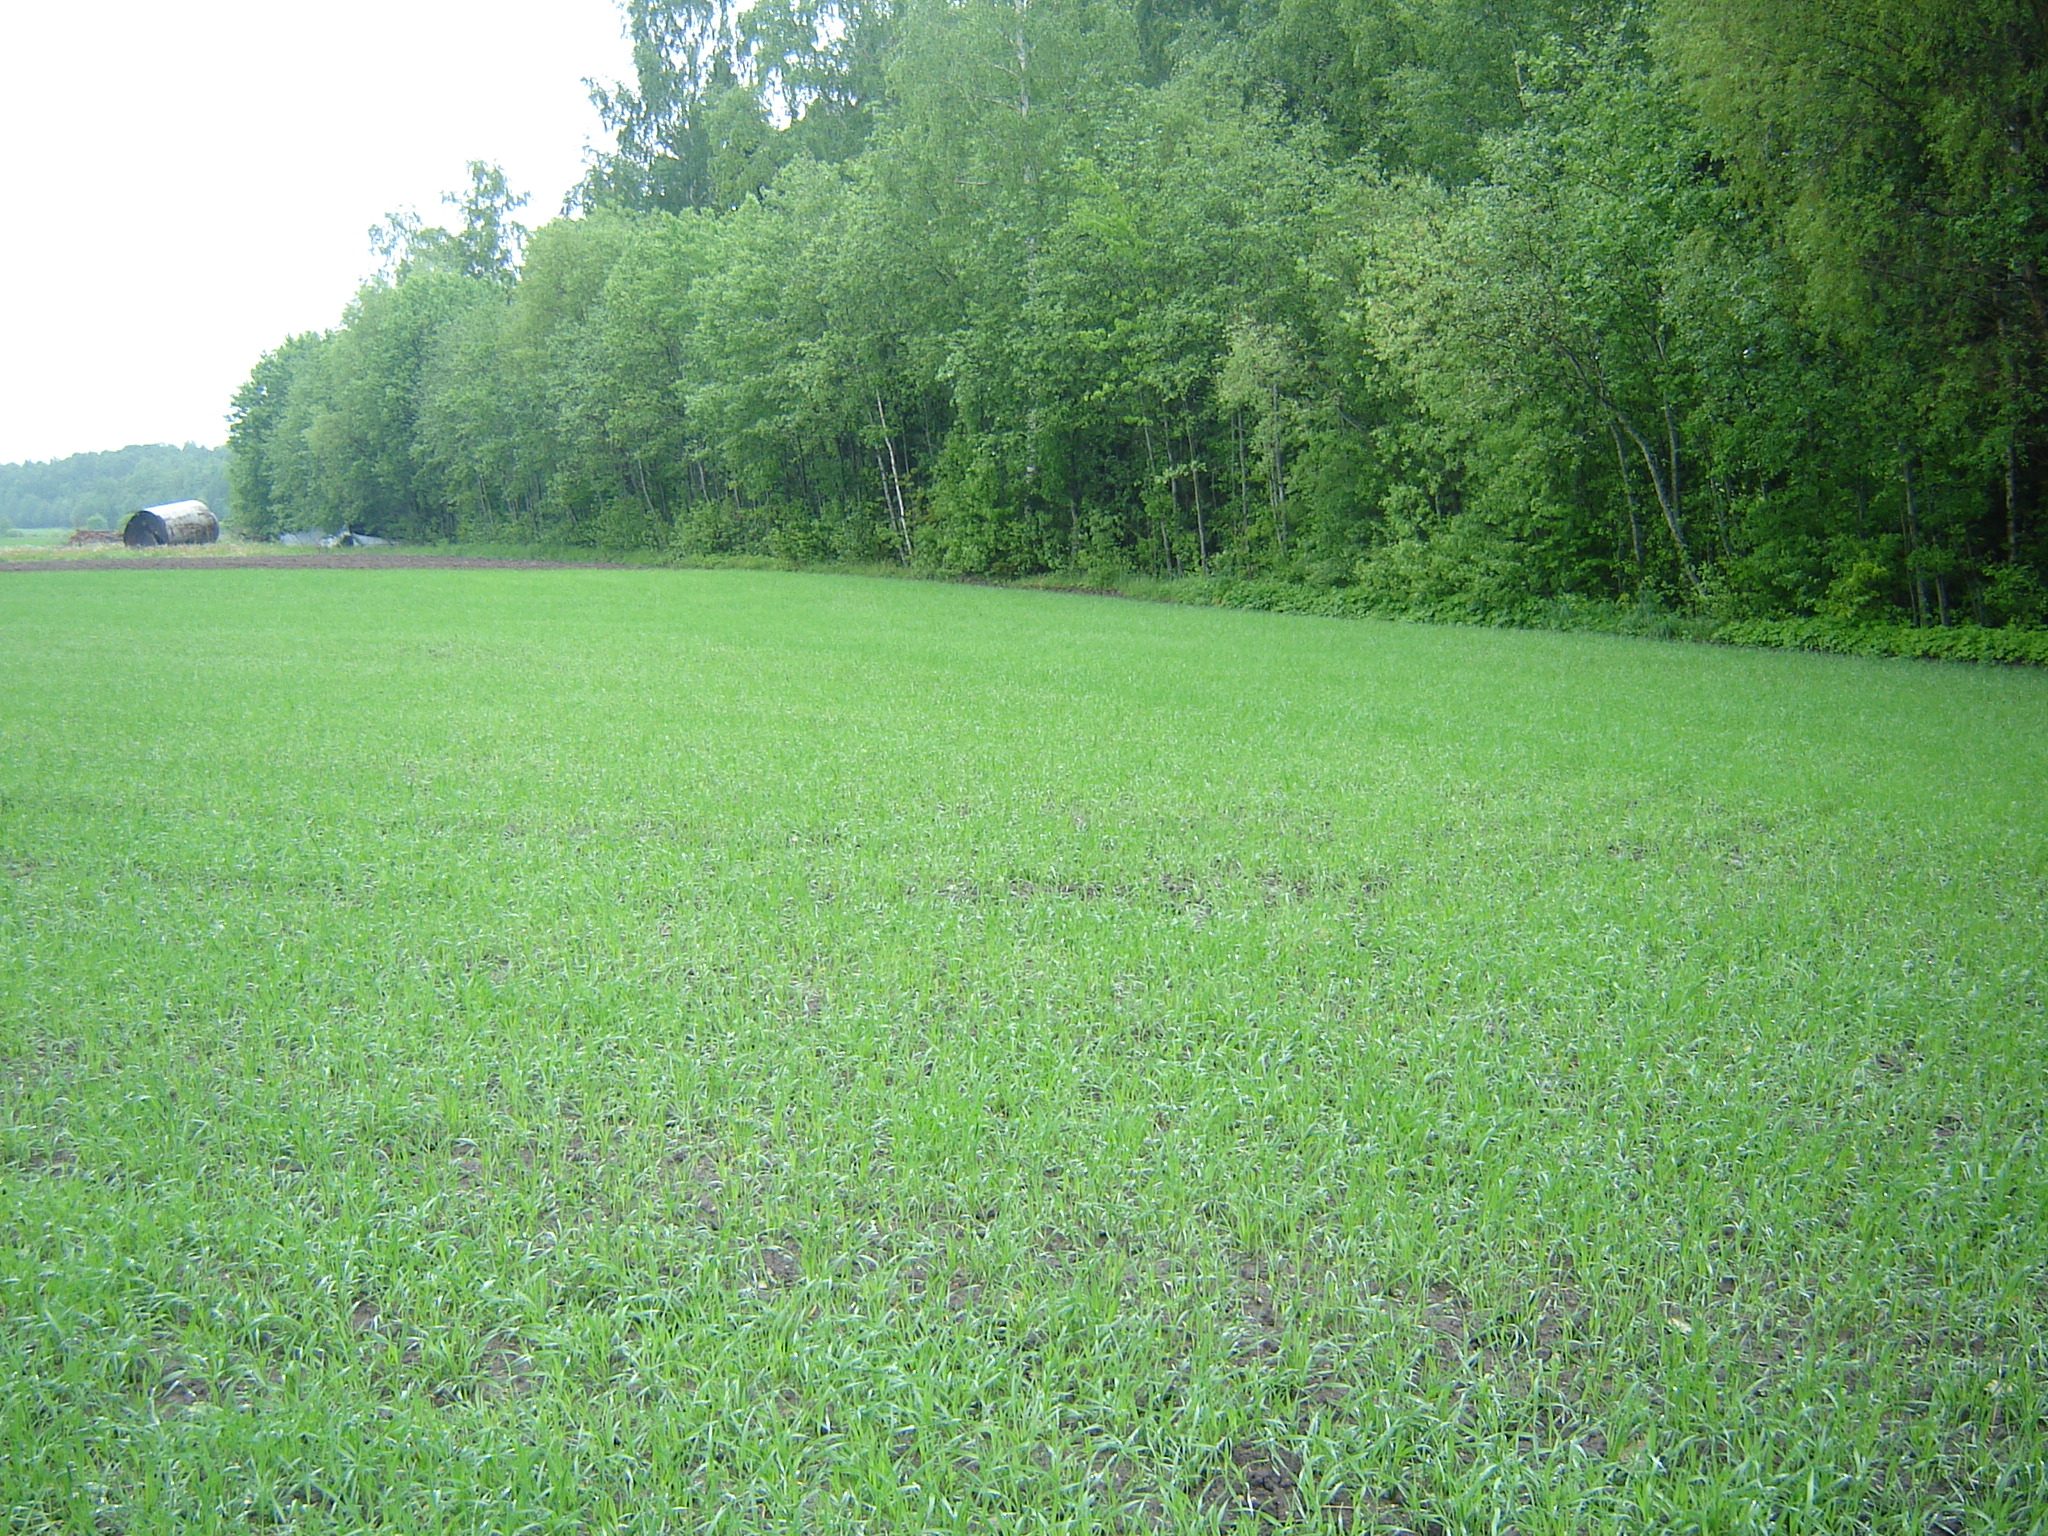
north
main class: Cropland
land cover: Common wheat
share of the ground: > 75 %
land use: Agriculture (excluding fallow land and kitchen gardens)
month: May
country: LT
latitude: 55.9159
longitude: 25.2032
